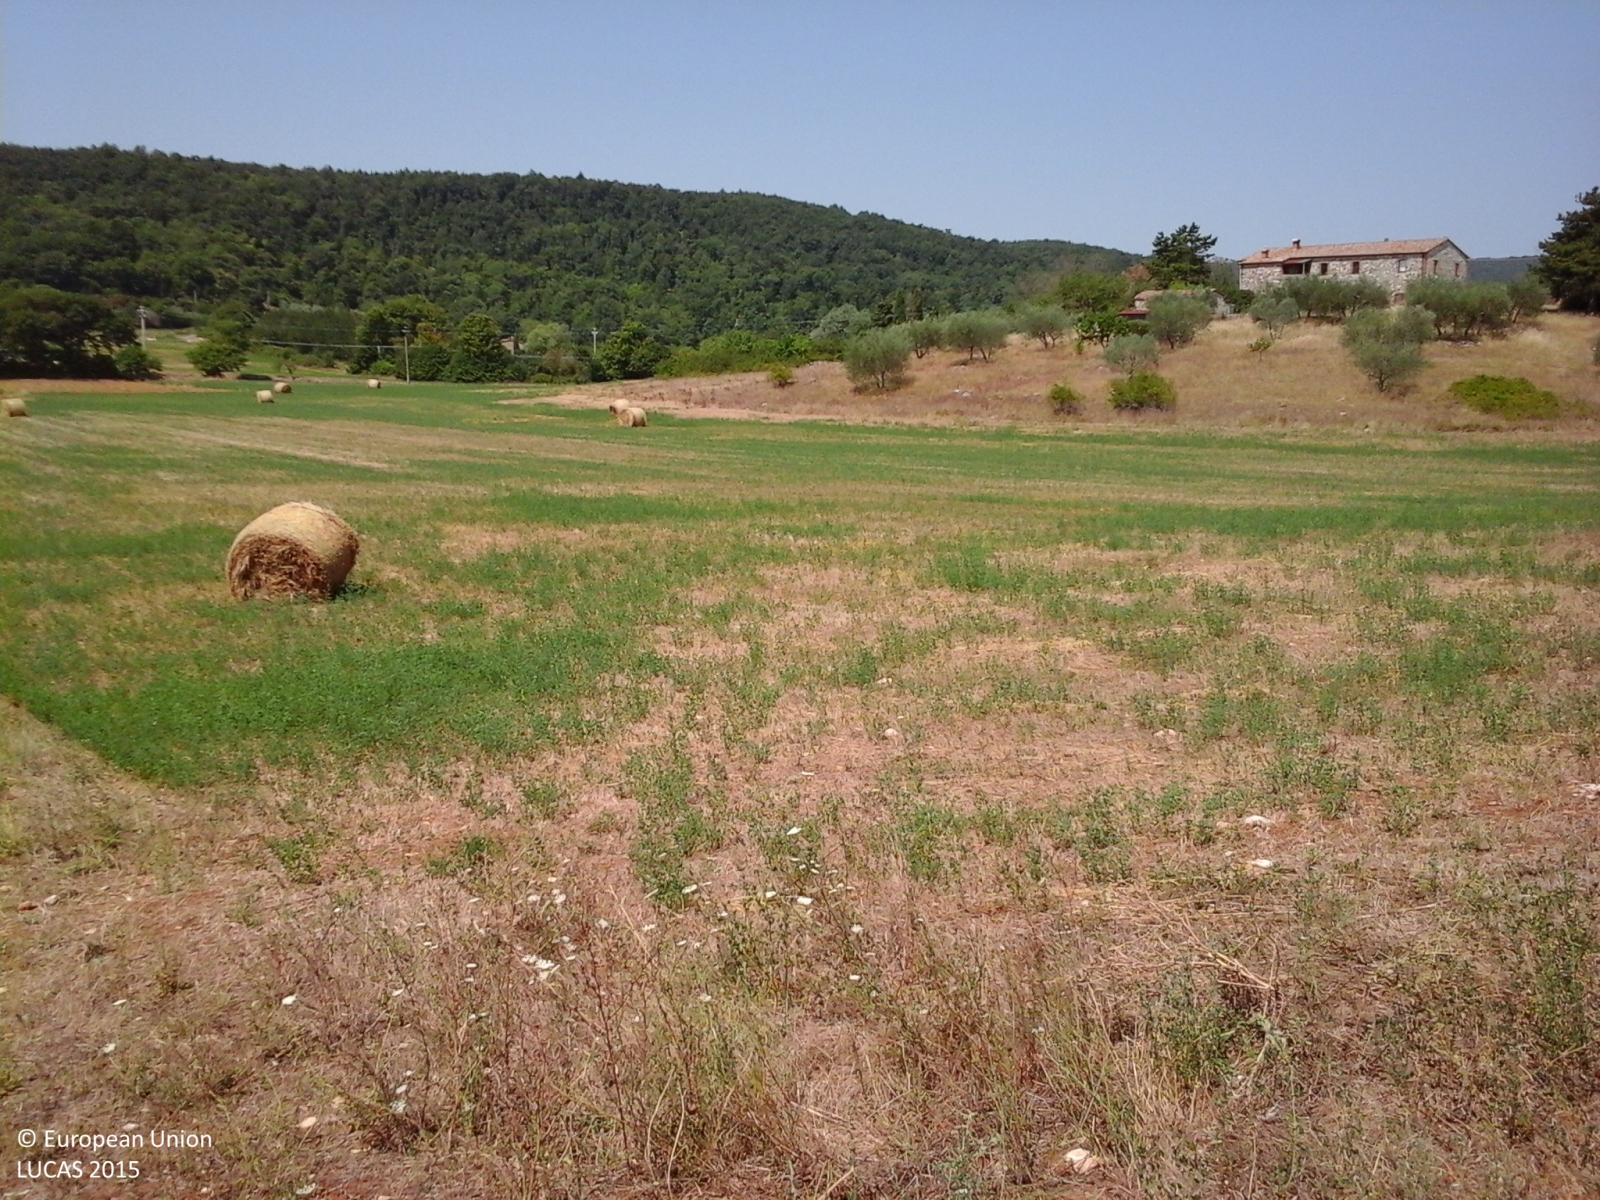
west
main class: Shrubland
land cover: Shrubland with sparse tree cover
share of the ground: > 75 %
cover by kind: shrubs 65 %, herbaceous plants 20 %, broadleaved forest trees 5 %, consolidated bare surface 5 %, unconsolidated bare surface 5 %
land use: Abandoned areas
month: July
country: IT
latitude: 42.9800
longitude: 11.8705
